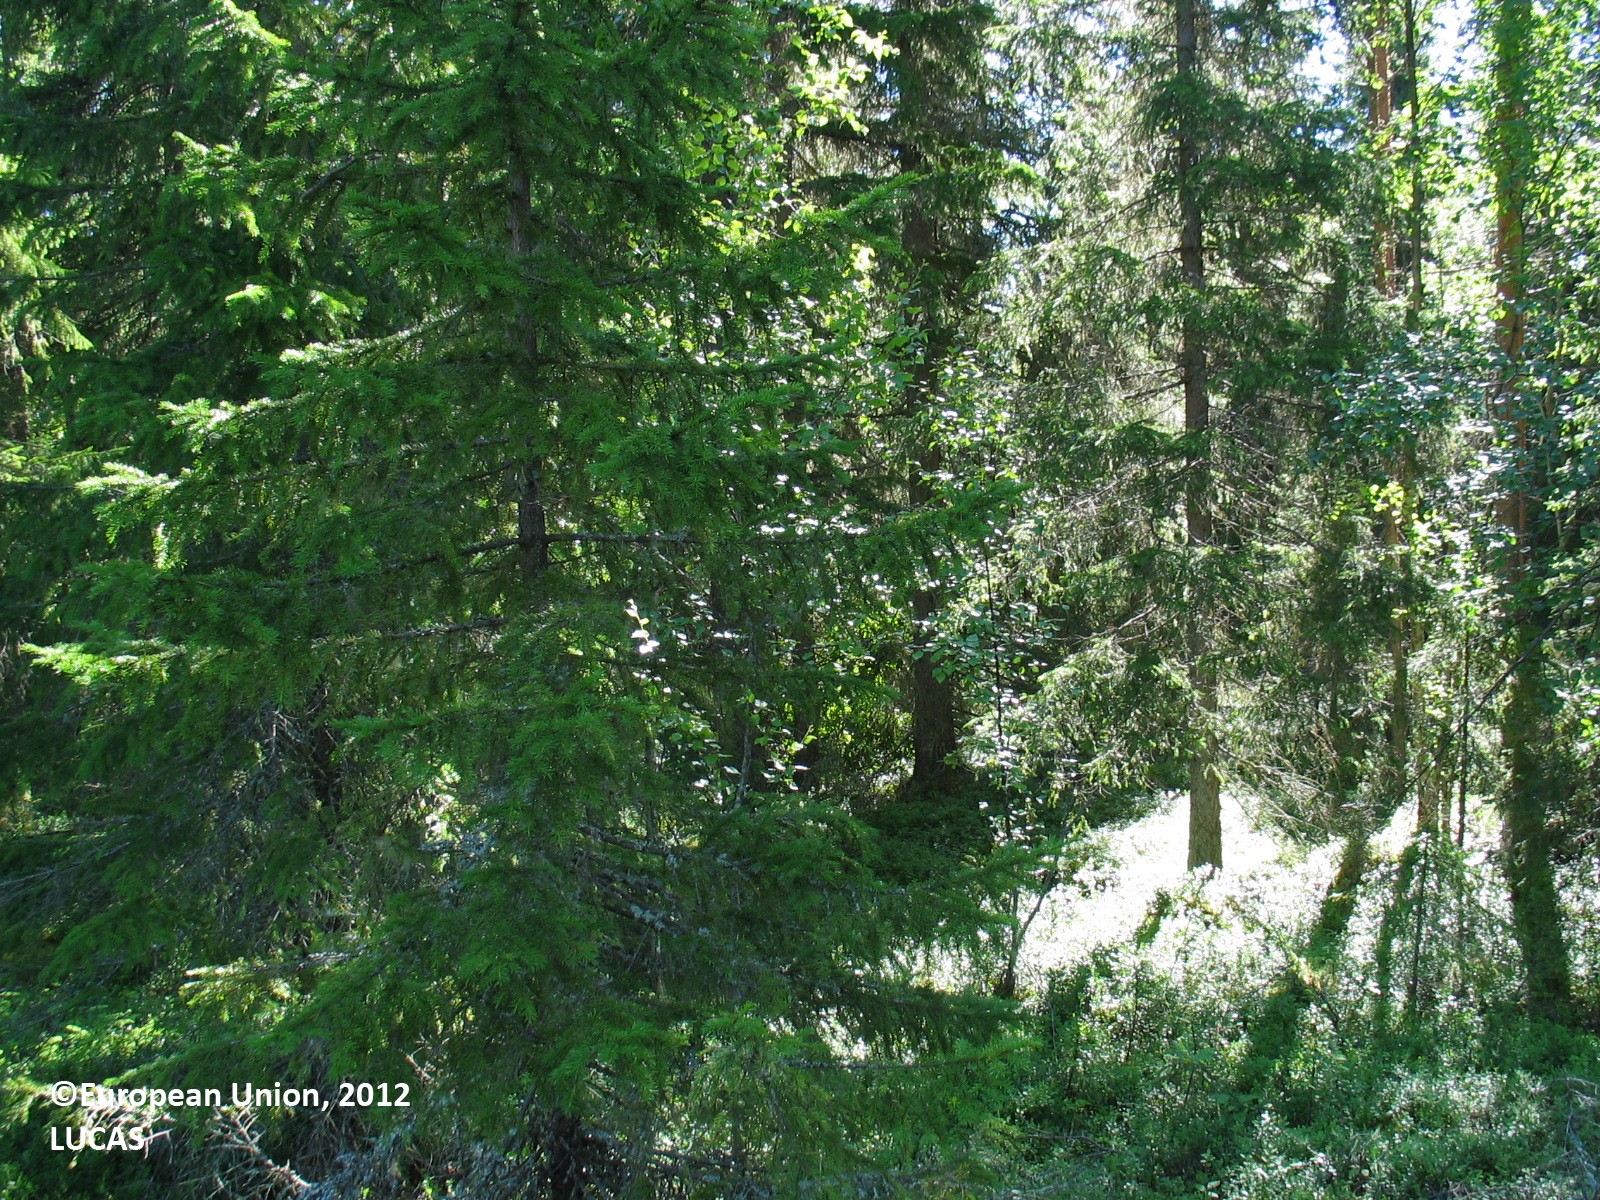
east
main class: Woodland
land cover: Other mixed woodland
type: boreal forest
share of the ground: 50 - 75 %
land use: Forestry
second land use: Sport
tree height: > 5 m
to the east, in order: Tracks; Other mixed woodland; Grass margins; Other mixed woodland; Ditches and canals; Other mixed woodland; Ditches and canals; Shrubland without tree cover; Electric lines; Grass margins; Other mixed woodland; Spruce dominated coniferous woodland
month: July
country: FI
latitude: 65.6598
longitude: 24.9589
